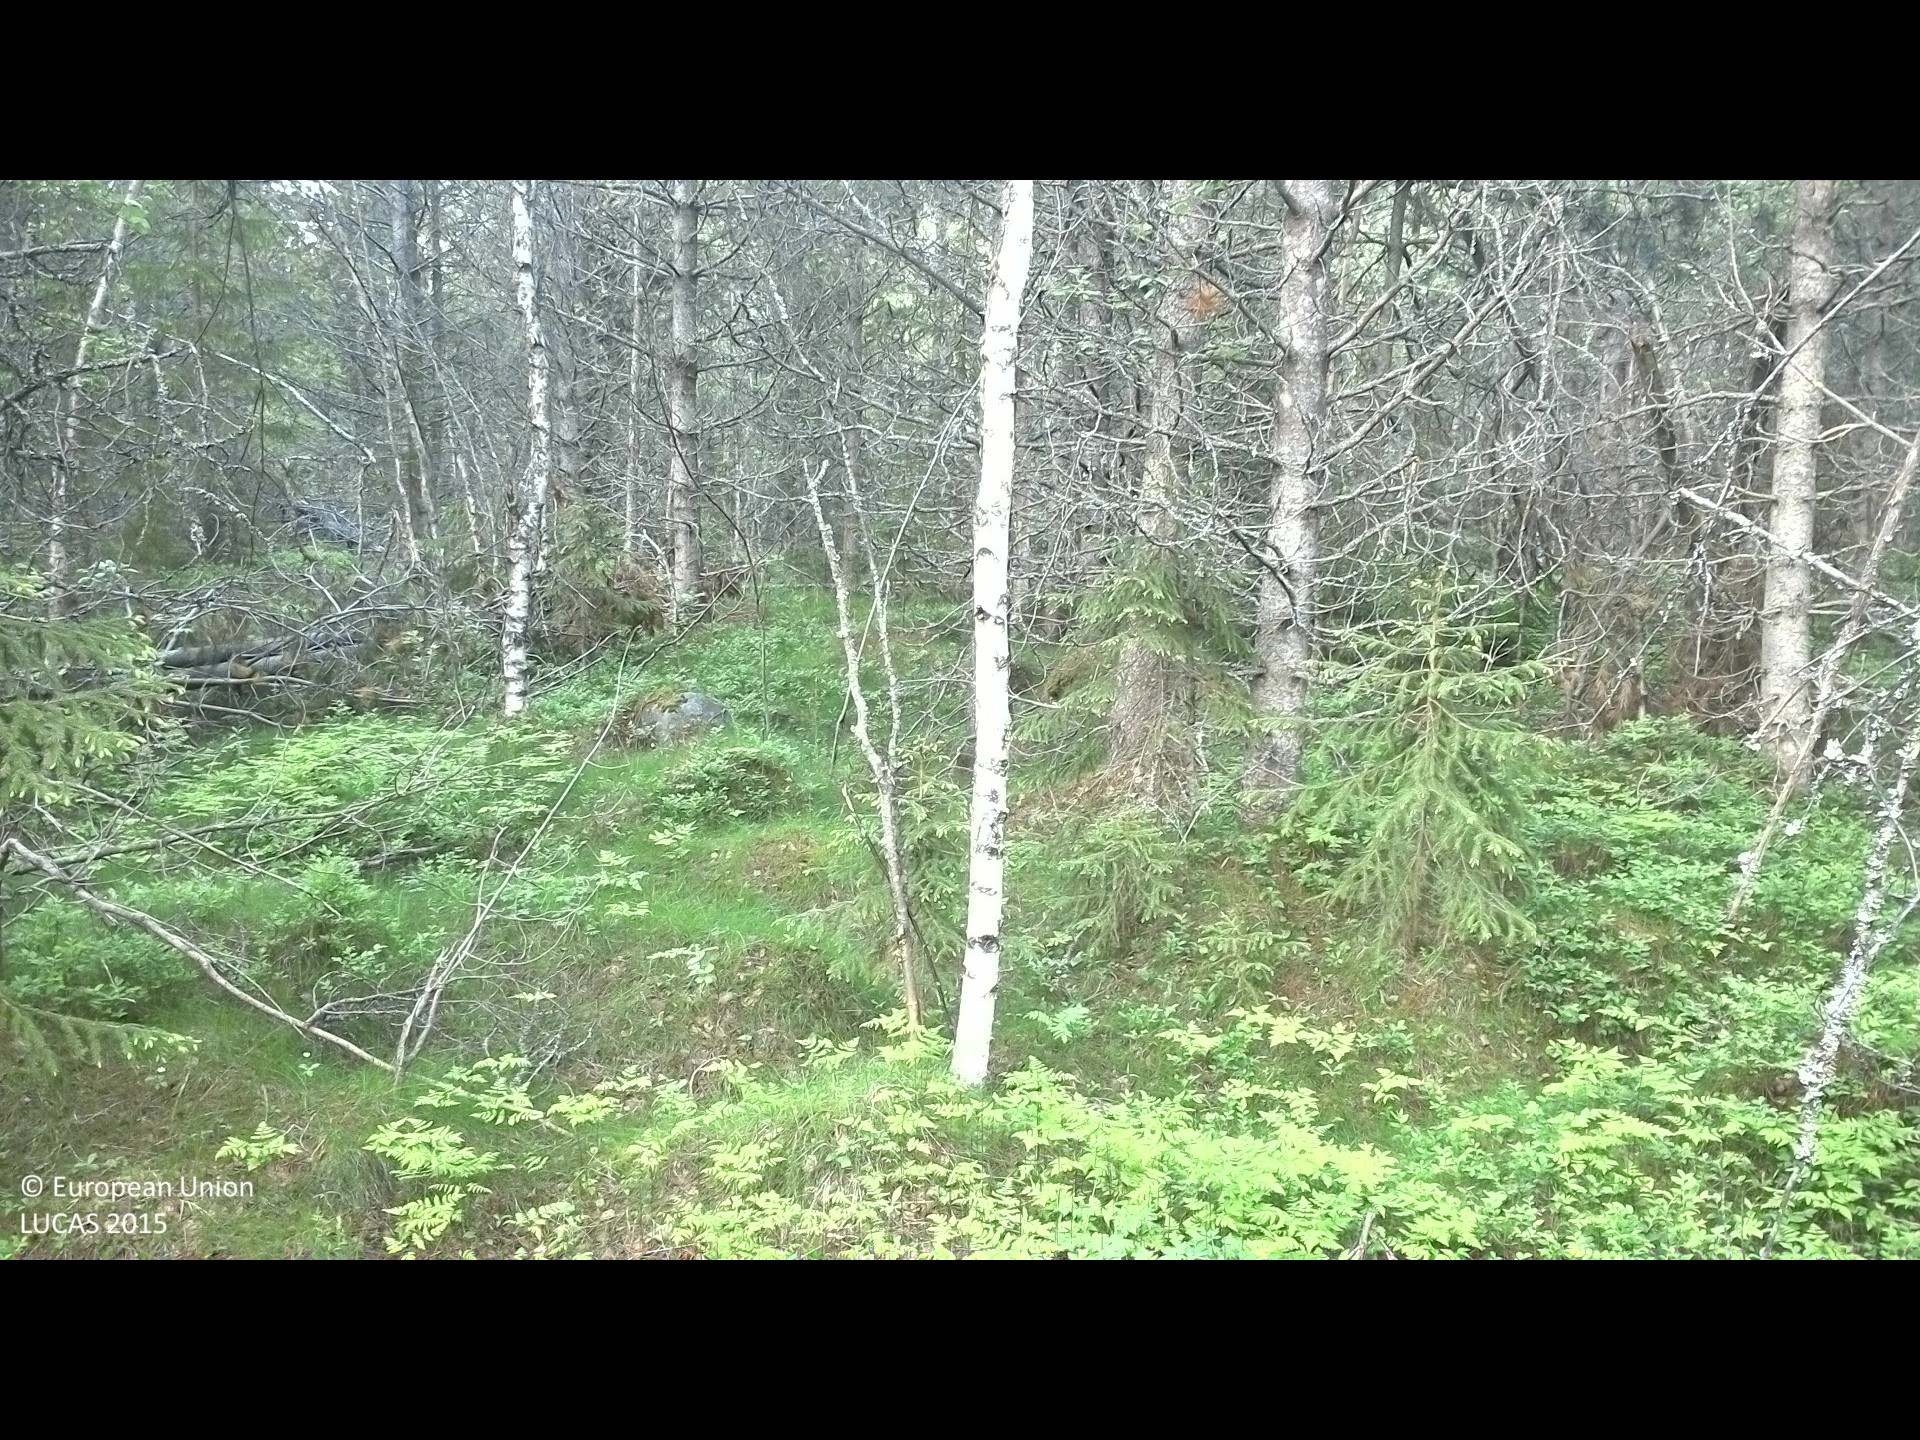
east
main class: Woodland
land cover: Pine dominated coniferous woodland
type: exotic forest
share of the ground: 50 - 75 %
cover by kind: coniferous forest trees 55 %, herbaceous plants 30 %, lichens and mosses 10 %, broadleaved forest trees 5 %
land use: Forestry
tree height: > 5 m
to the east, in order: Pine dominated coniferous woodland; Pine dominated mixed woodland; Pine dominated coniferous woodland; Other mixed woodland
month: June
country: SE
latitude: 62.0472
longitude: 16.6939
